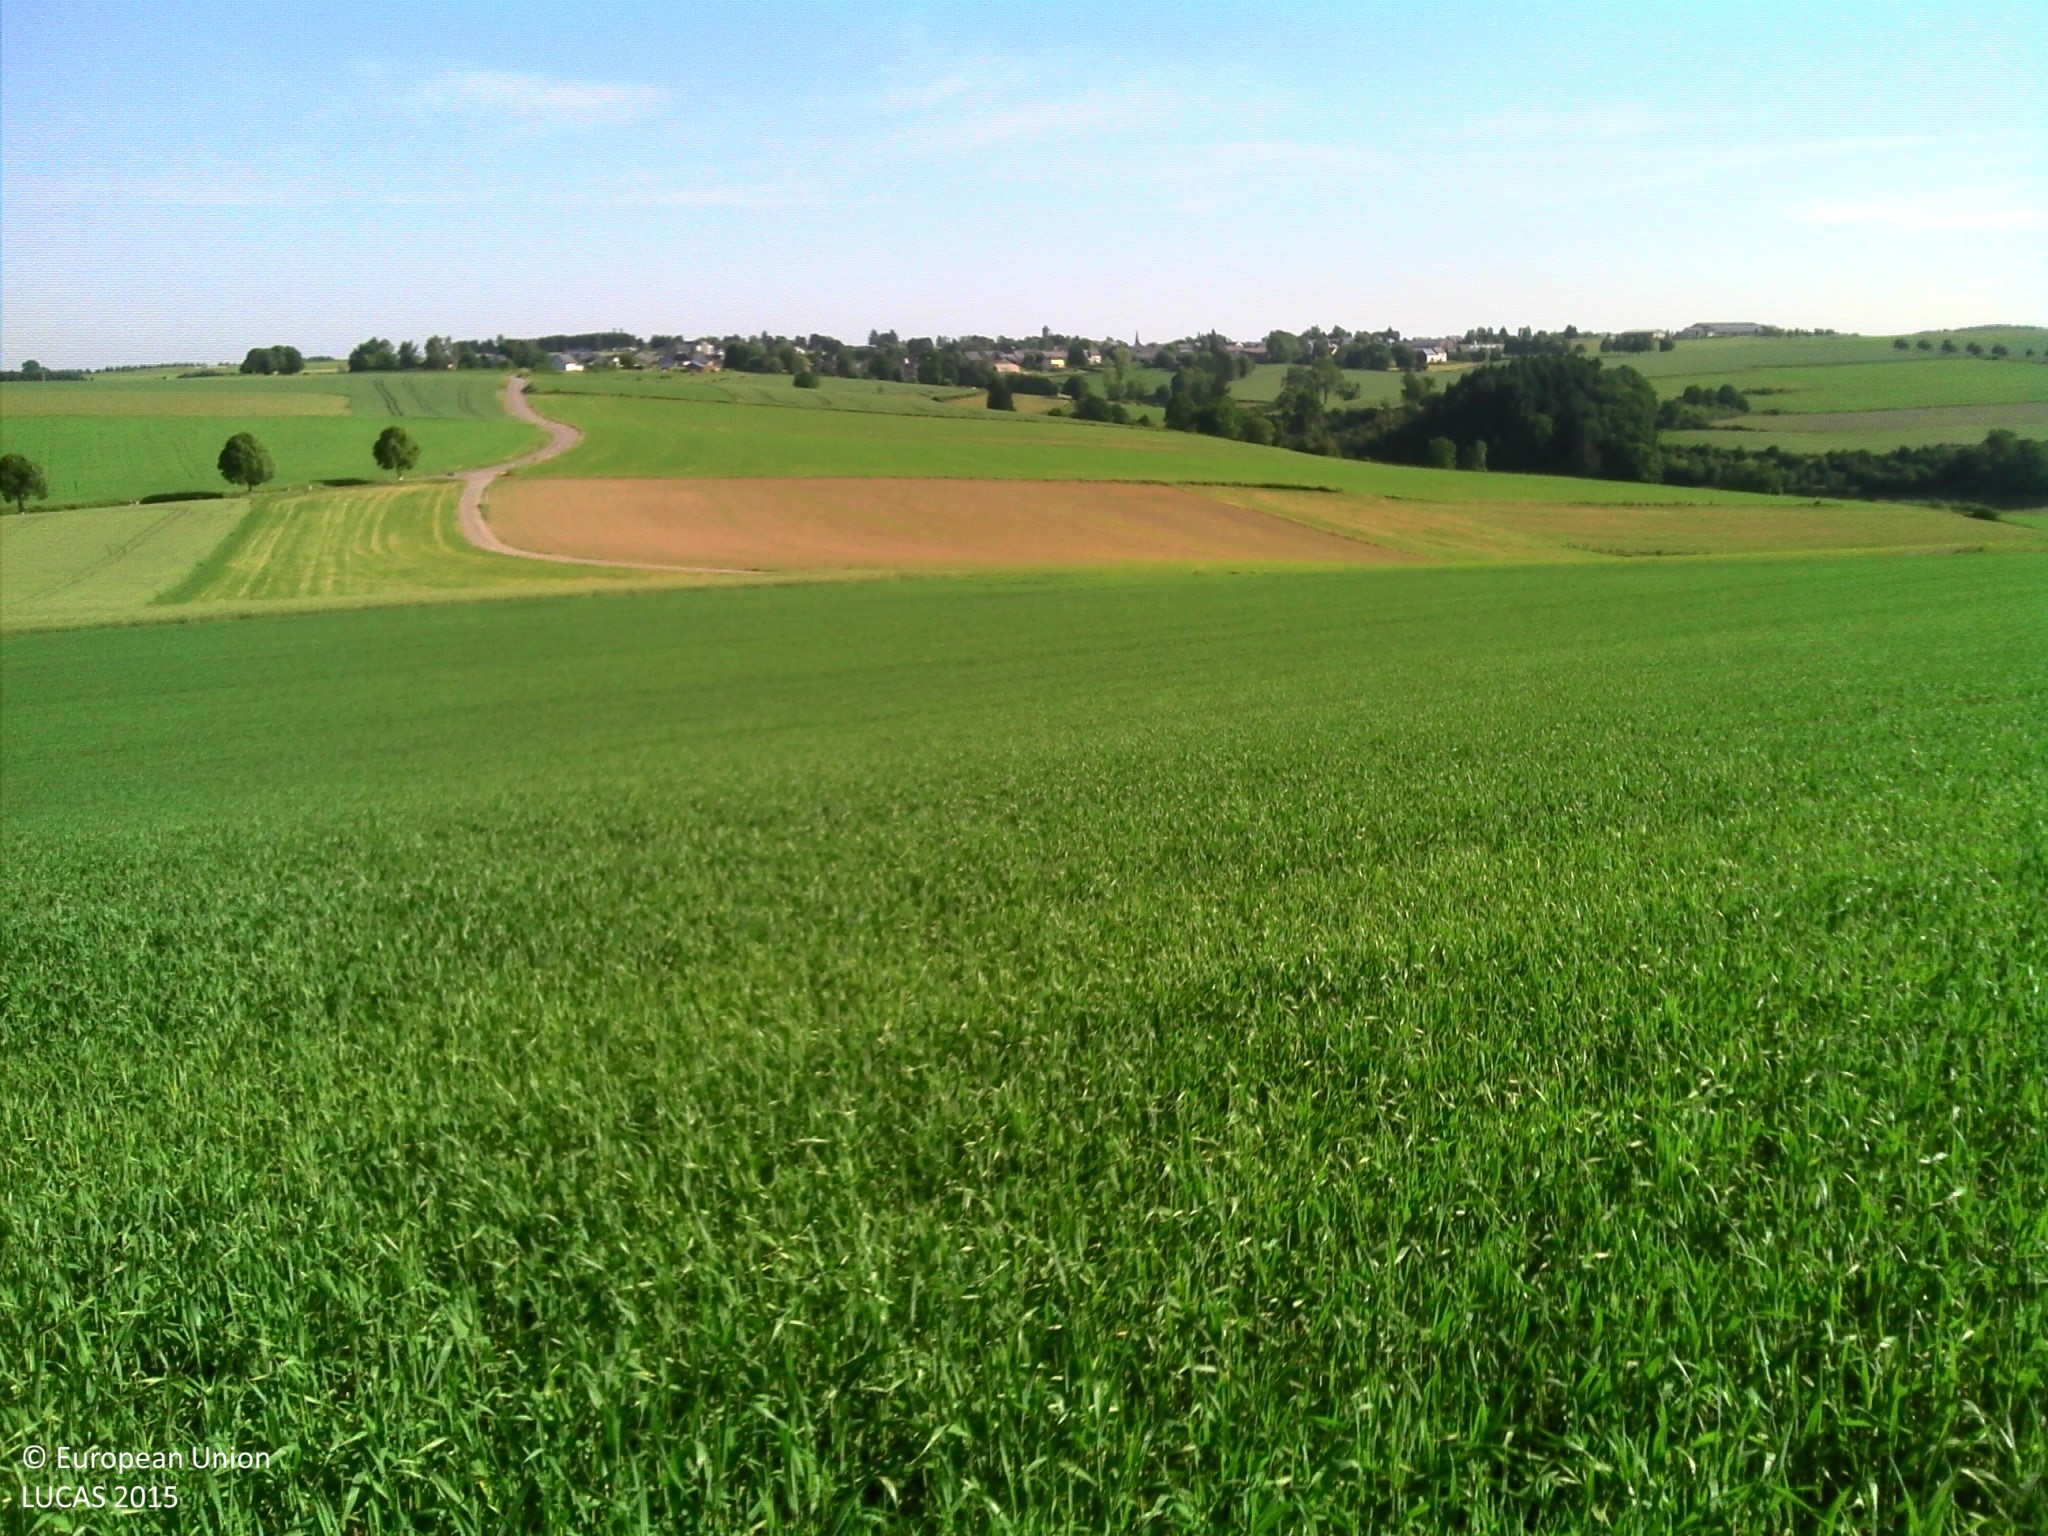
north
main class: Cropland
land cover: Triticale
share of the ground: > 75 %
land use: Agriculture (excluding fallow land and kitchen gardens)
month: June
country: LU
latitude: 49.8732
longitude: 5.8106
